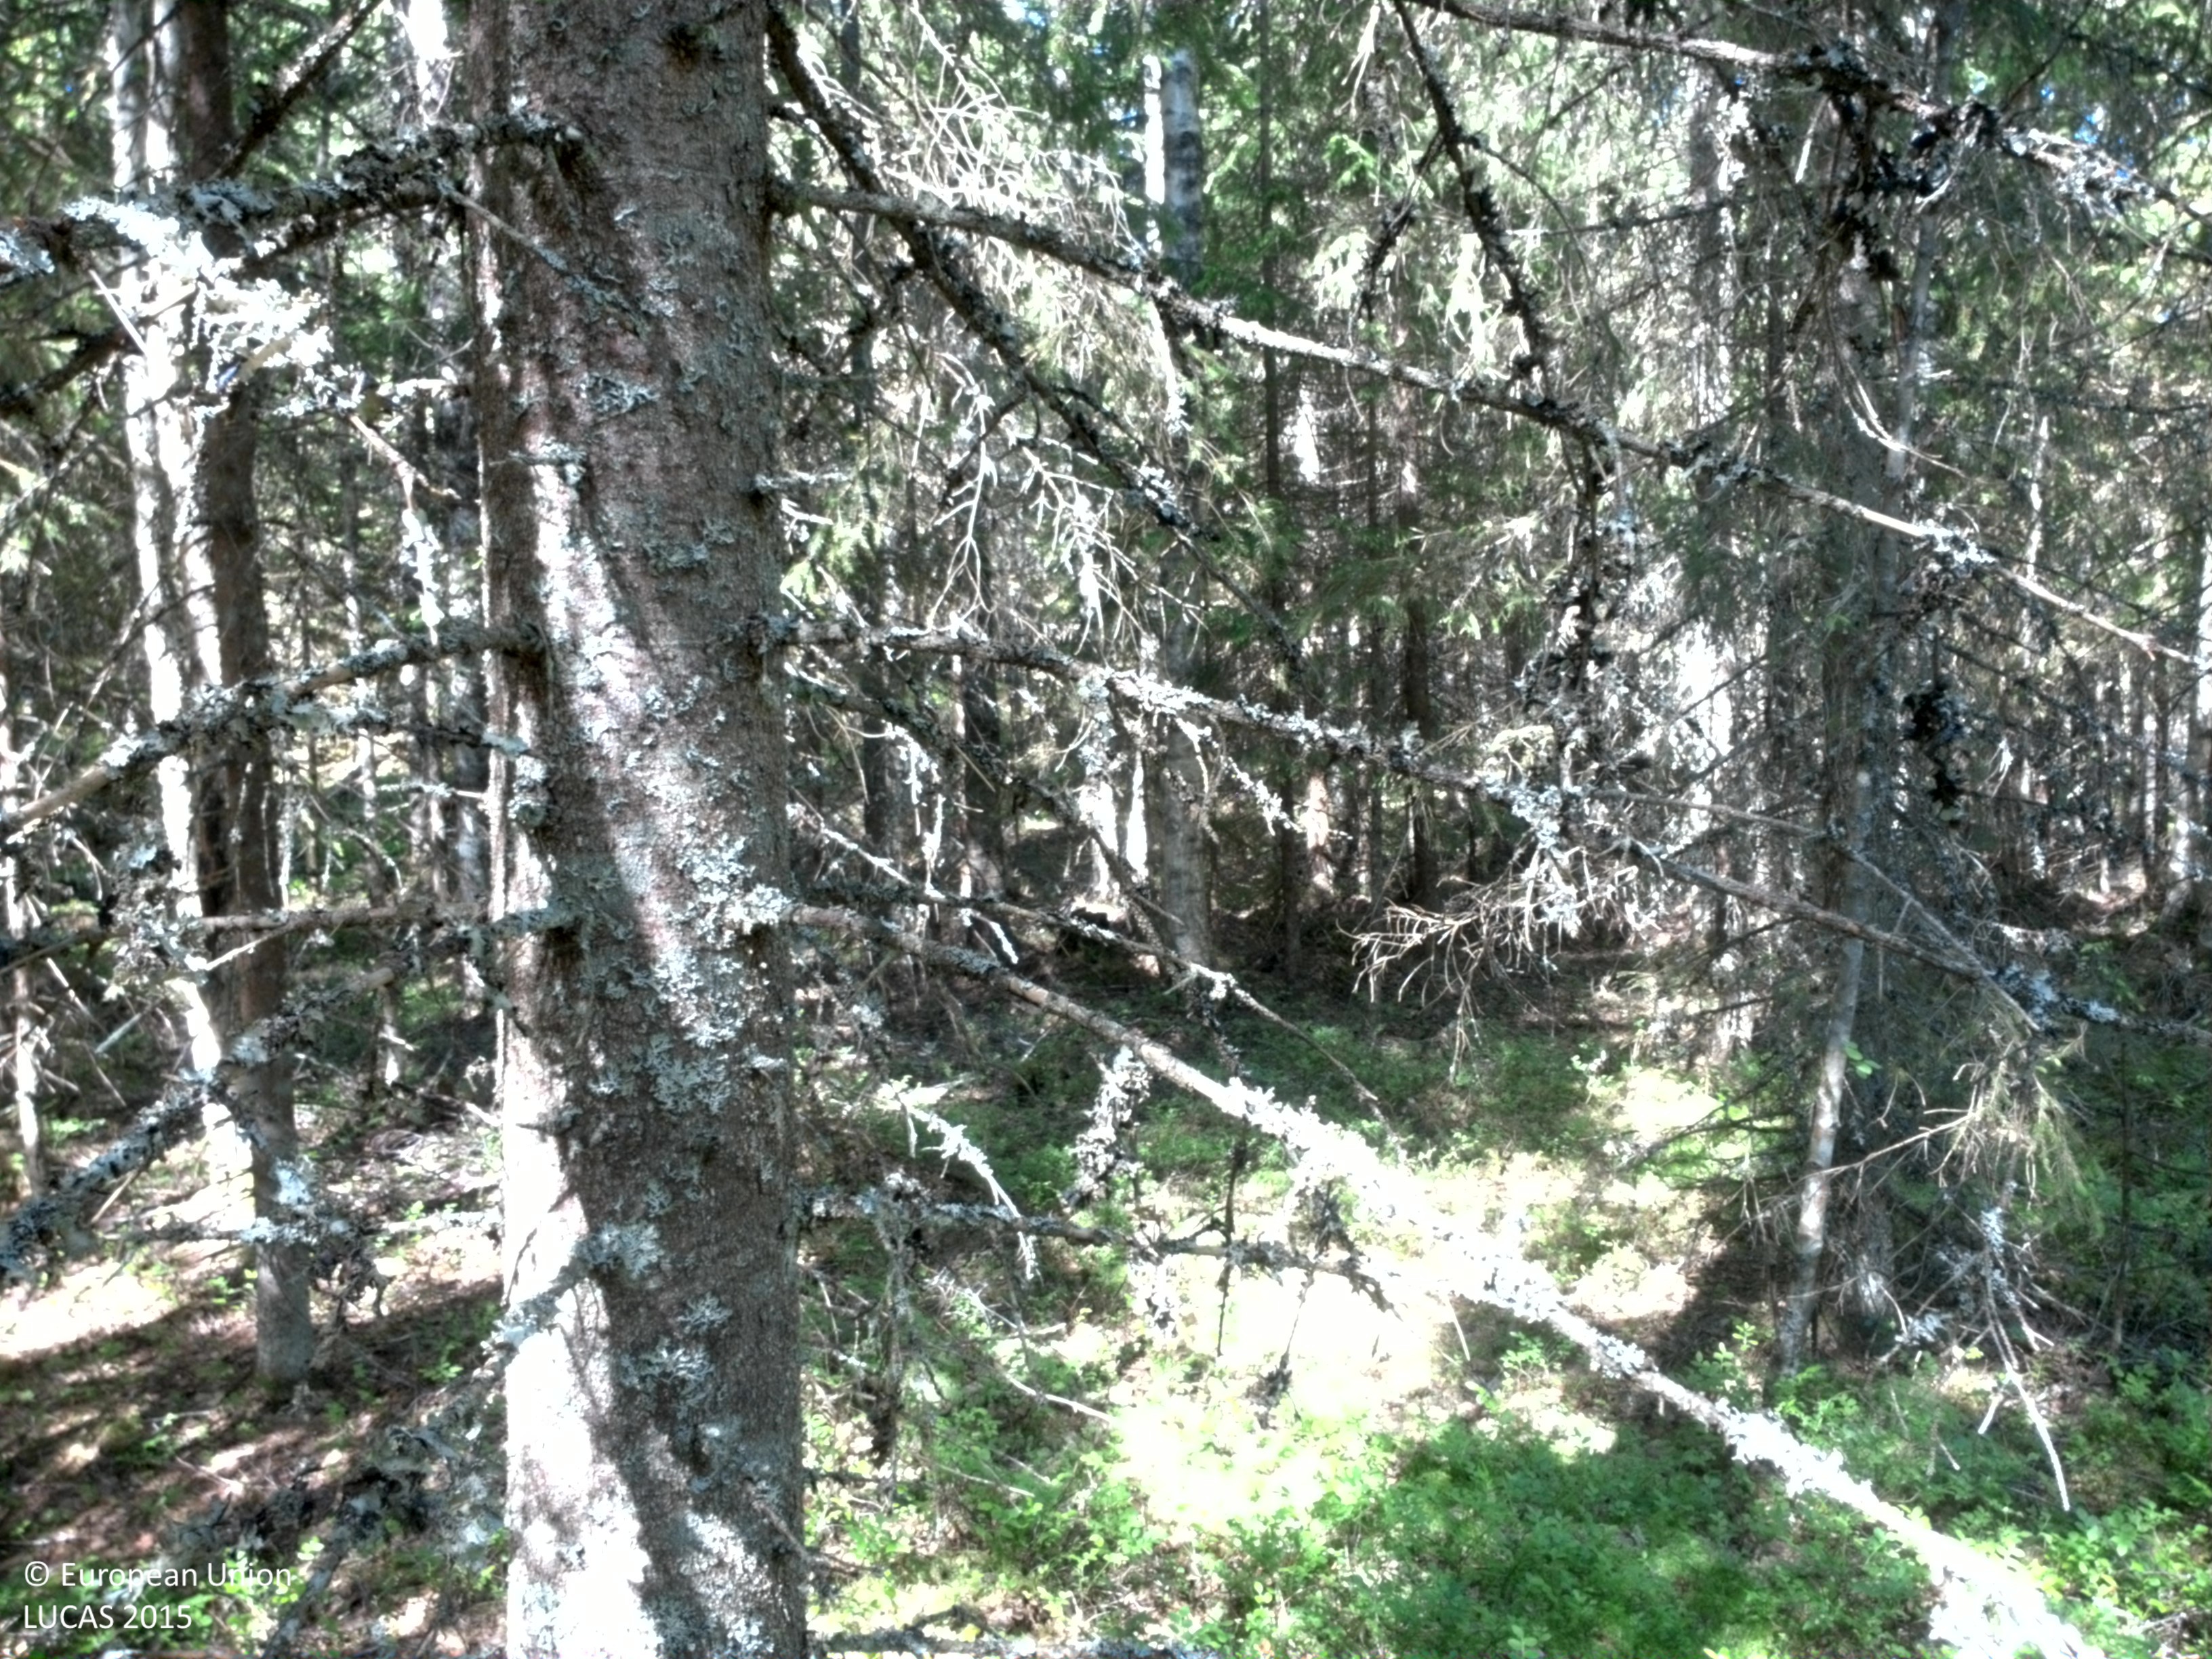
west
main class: Woodland
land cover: Spruce dominated mixed woodland
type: boreal forest
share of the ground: 50 - 75 %
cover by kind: coniferous forest trees 45 %, shrubs 25 %, broadleaved forest trees 15 %, lichens and mosses 15 %
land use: Forestry
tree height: > 5 m
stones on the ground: < 10 %
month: July
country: SE
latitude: 59.7712
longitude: 11.9356
